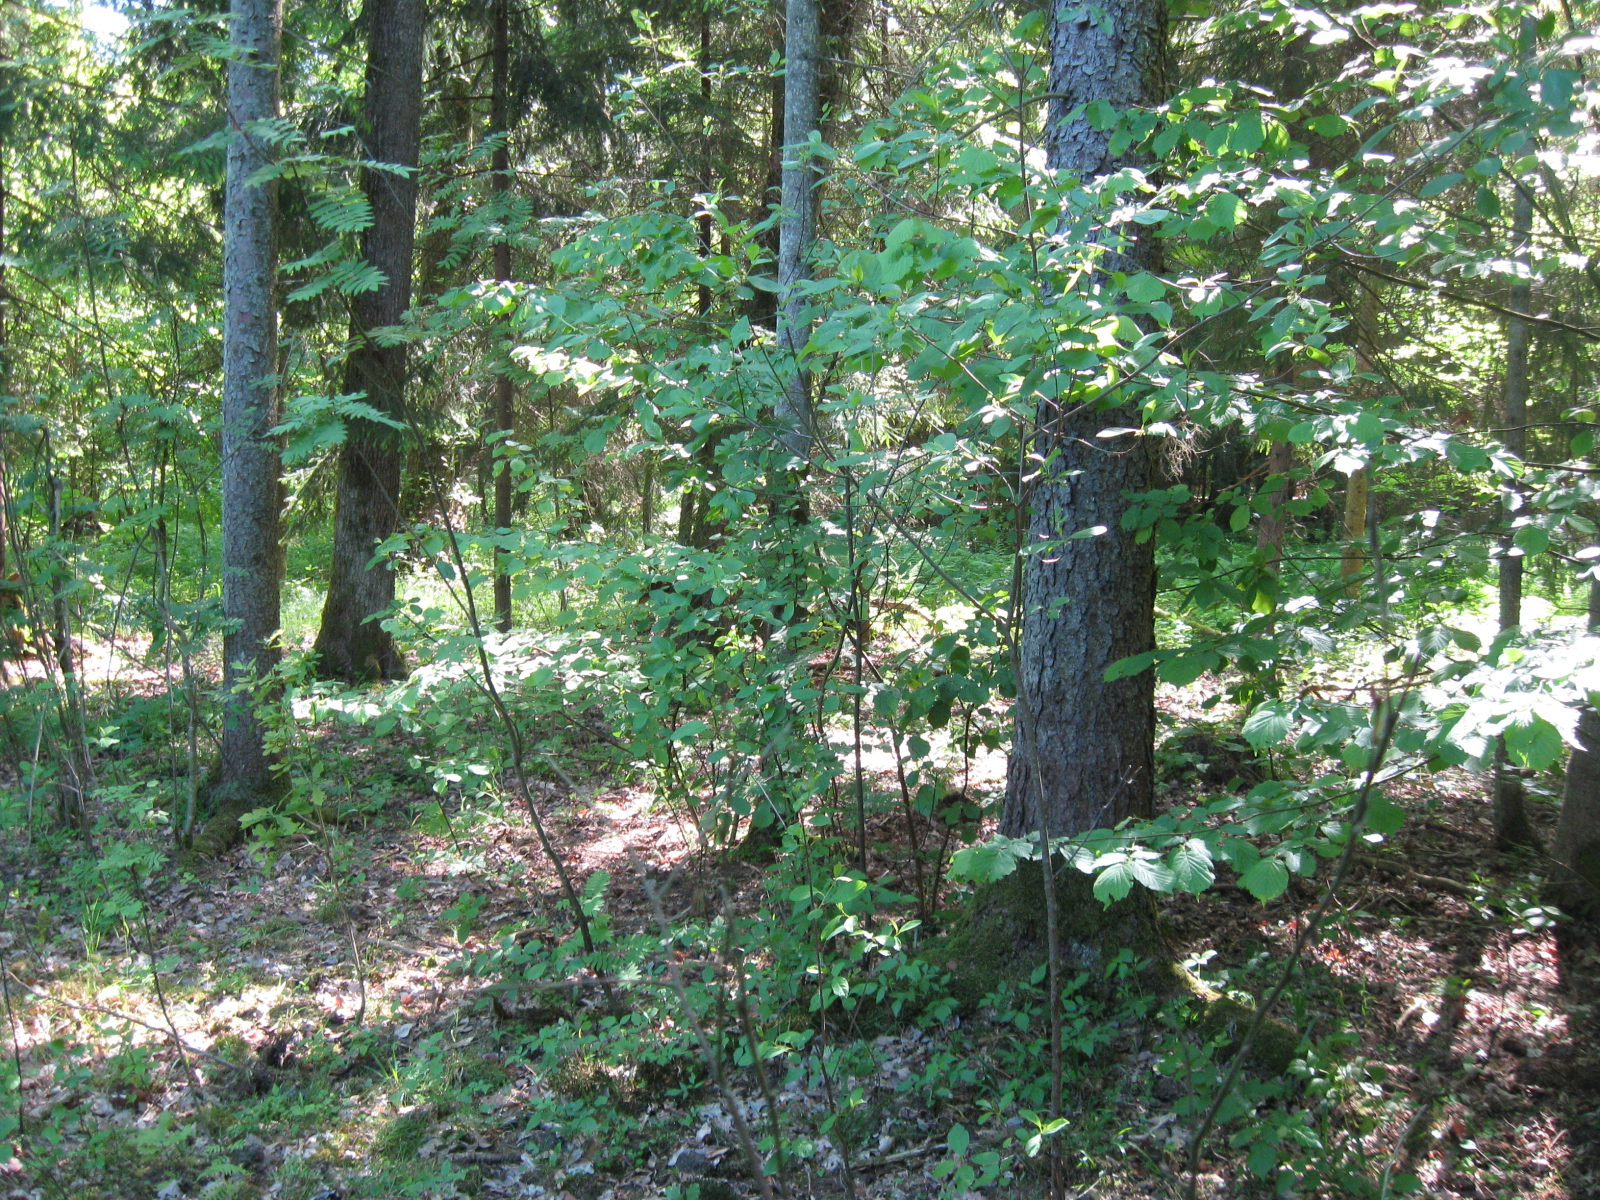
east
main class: Woodland
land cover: Spruce dominated mixed woodland
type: hemiboreal forest and nemoral coniferous forest and mixed broadleaved-coniferous forest
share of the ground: > 75 %
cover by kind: broadleaved forest trees 55 %, coniferous forest trees 40 %, herbaceous plants 5 %
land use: Forestry
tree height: > 5 m
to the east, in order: Spruce dominated mixed woodland; Ditches and canals; Spruce dominated mixed woodland
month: June
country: LT
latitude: 54.5565
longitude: 23.8349
